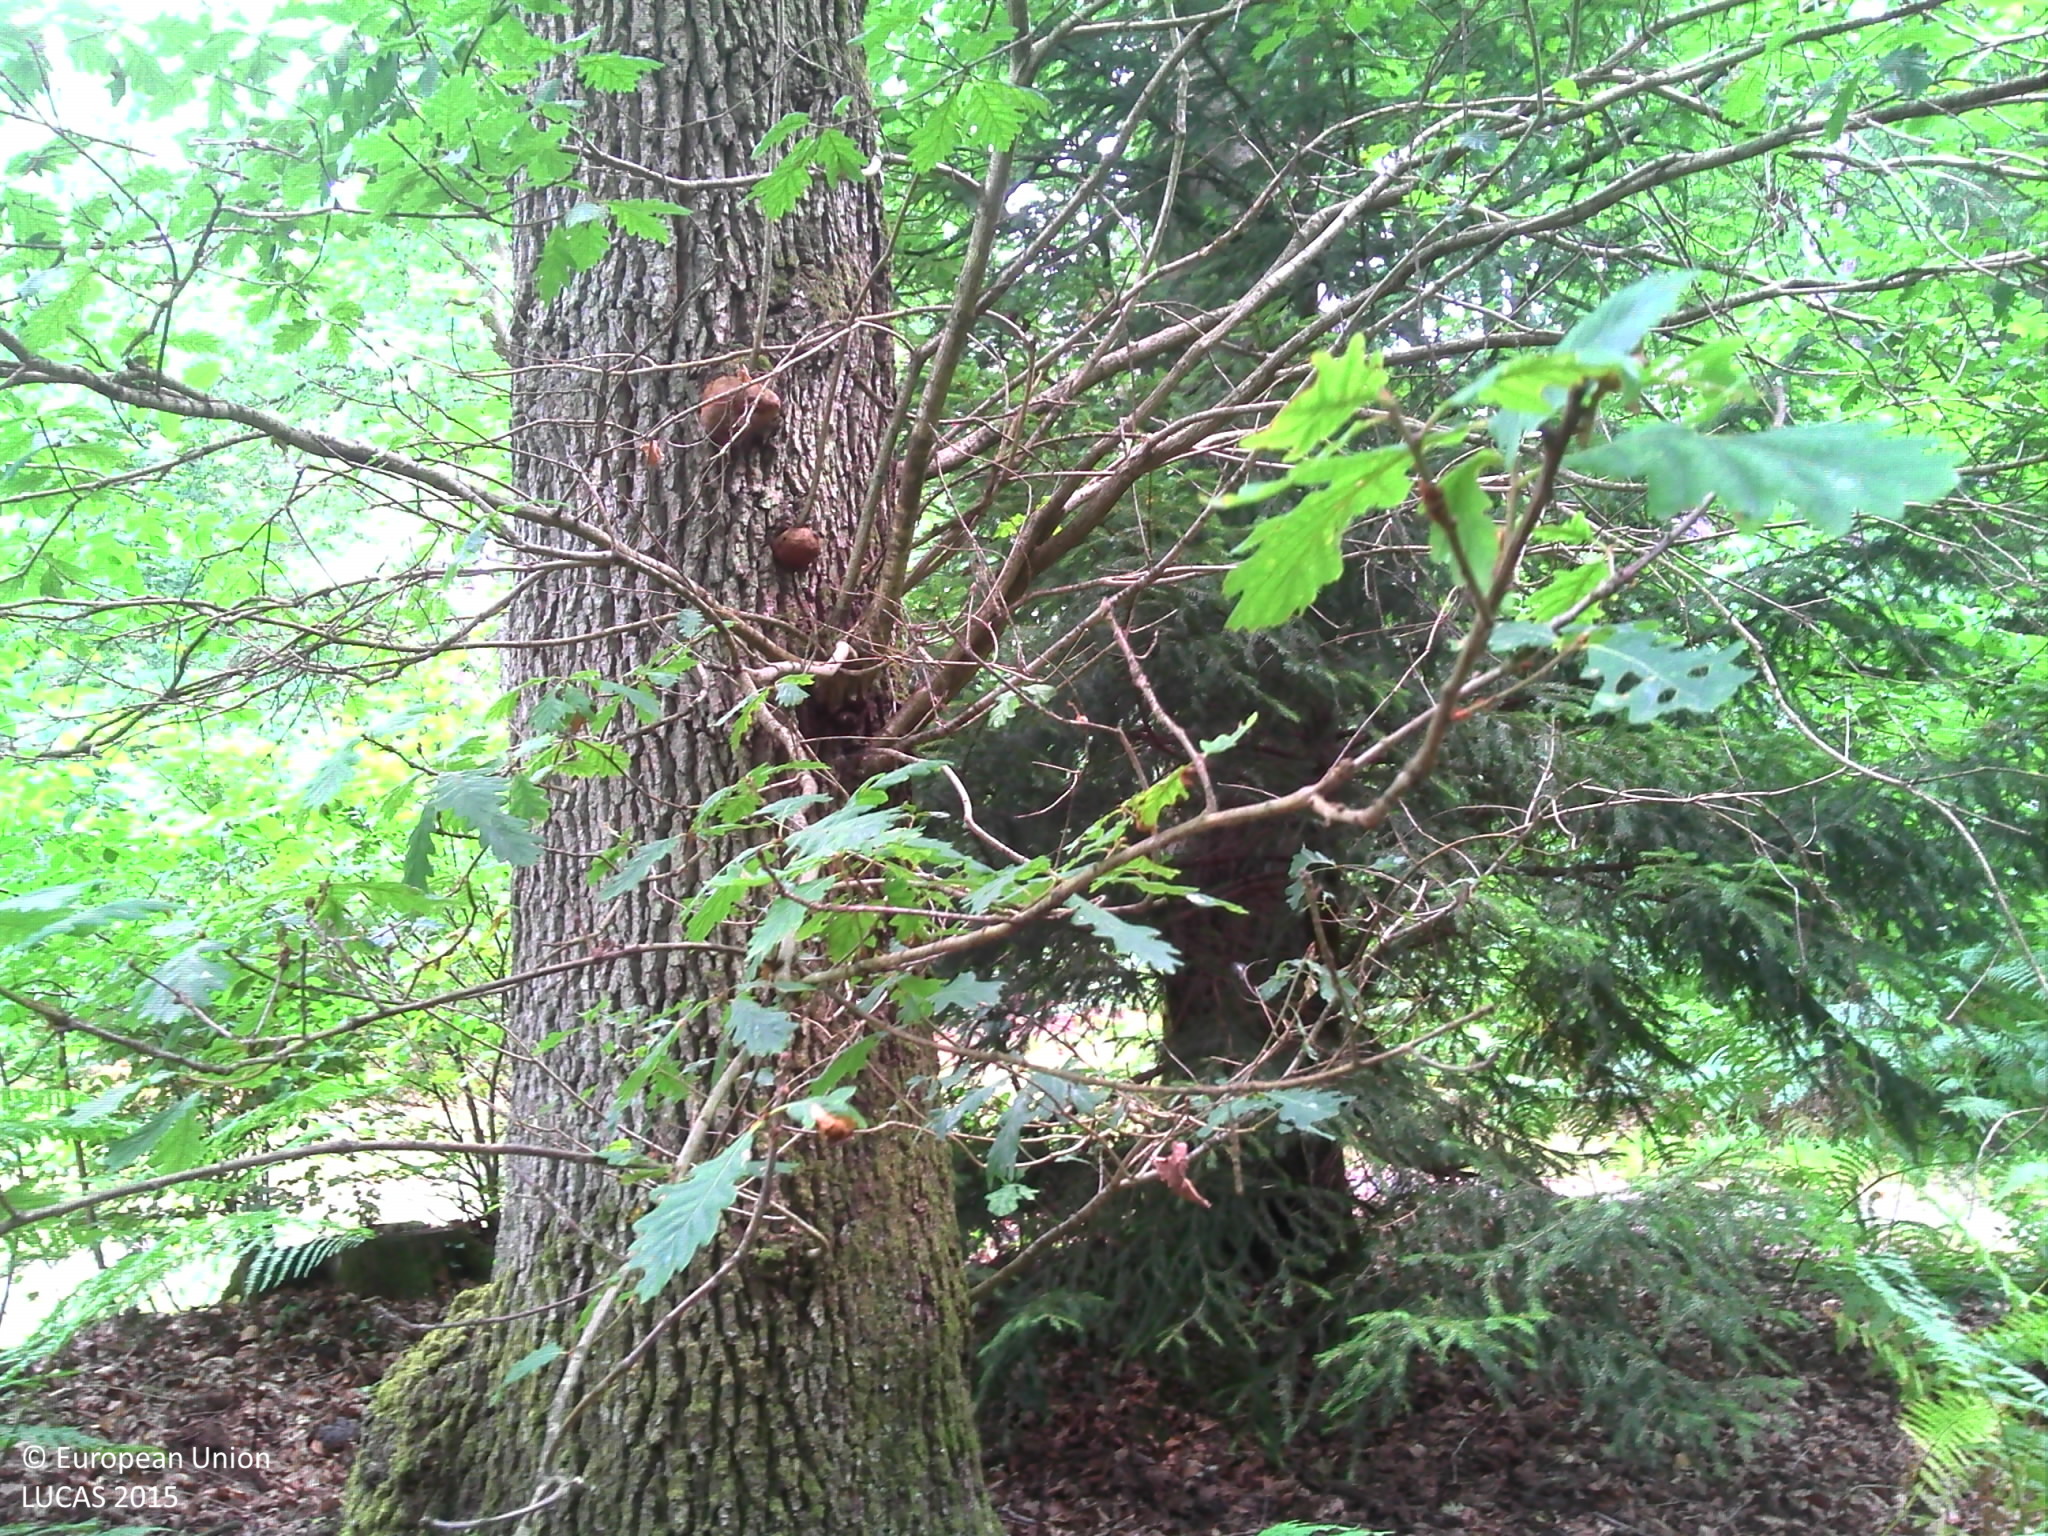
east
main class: Woodland
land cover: Pine dominated mixed woodland
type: hemiboreal forest and nemoral coniferous forest and mixed broadleaved-coniferous forest
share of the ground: > 75 %
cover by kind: coniferous forest trees 40 %, broadleaved forest trees 20 %, herbaceous plants 15 %, lichens and mosses 10 %, unconsolidated bare surface 10 %
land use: Forestry
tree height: > 5 m
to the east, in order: Pine dominated mixed woodland; Tracks; Pine dominated mixed woodland; Tracks; Pine dominated mixed woodland; Tracks; Pine dominated mixed woodland; Pine dominated coniferous woodland; Pine dominated mixed woodland
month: July
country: FR
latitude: 48.4352
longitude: 2.7324
